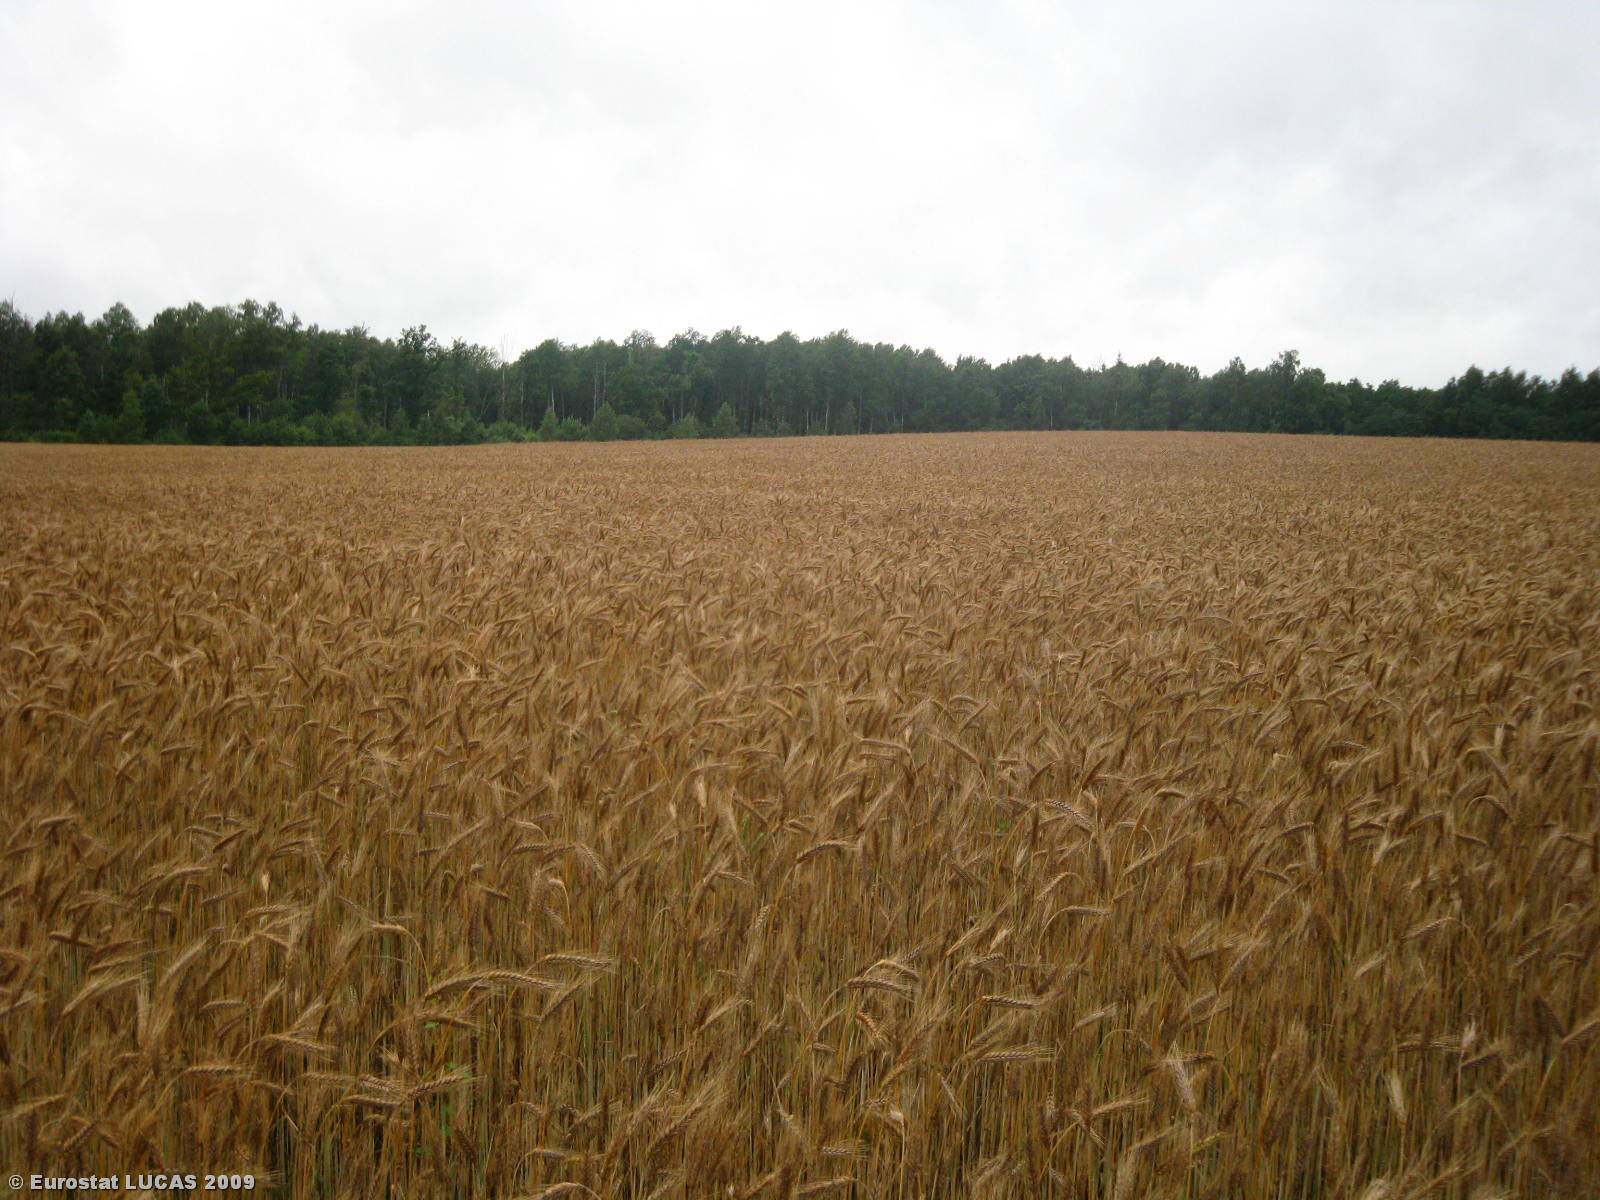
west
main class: Cropland
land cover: Rye
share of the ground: > 75 %
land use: Agriculture (excluding fallow land and kitchen gardens)
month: July
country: LT
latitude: 55.4740
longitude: 23.9628
